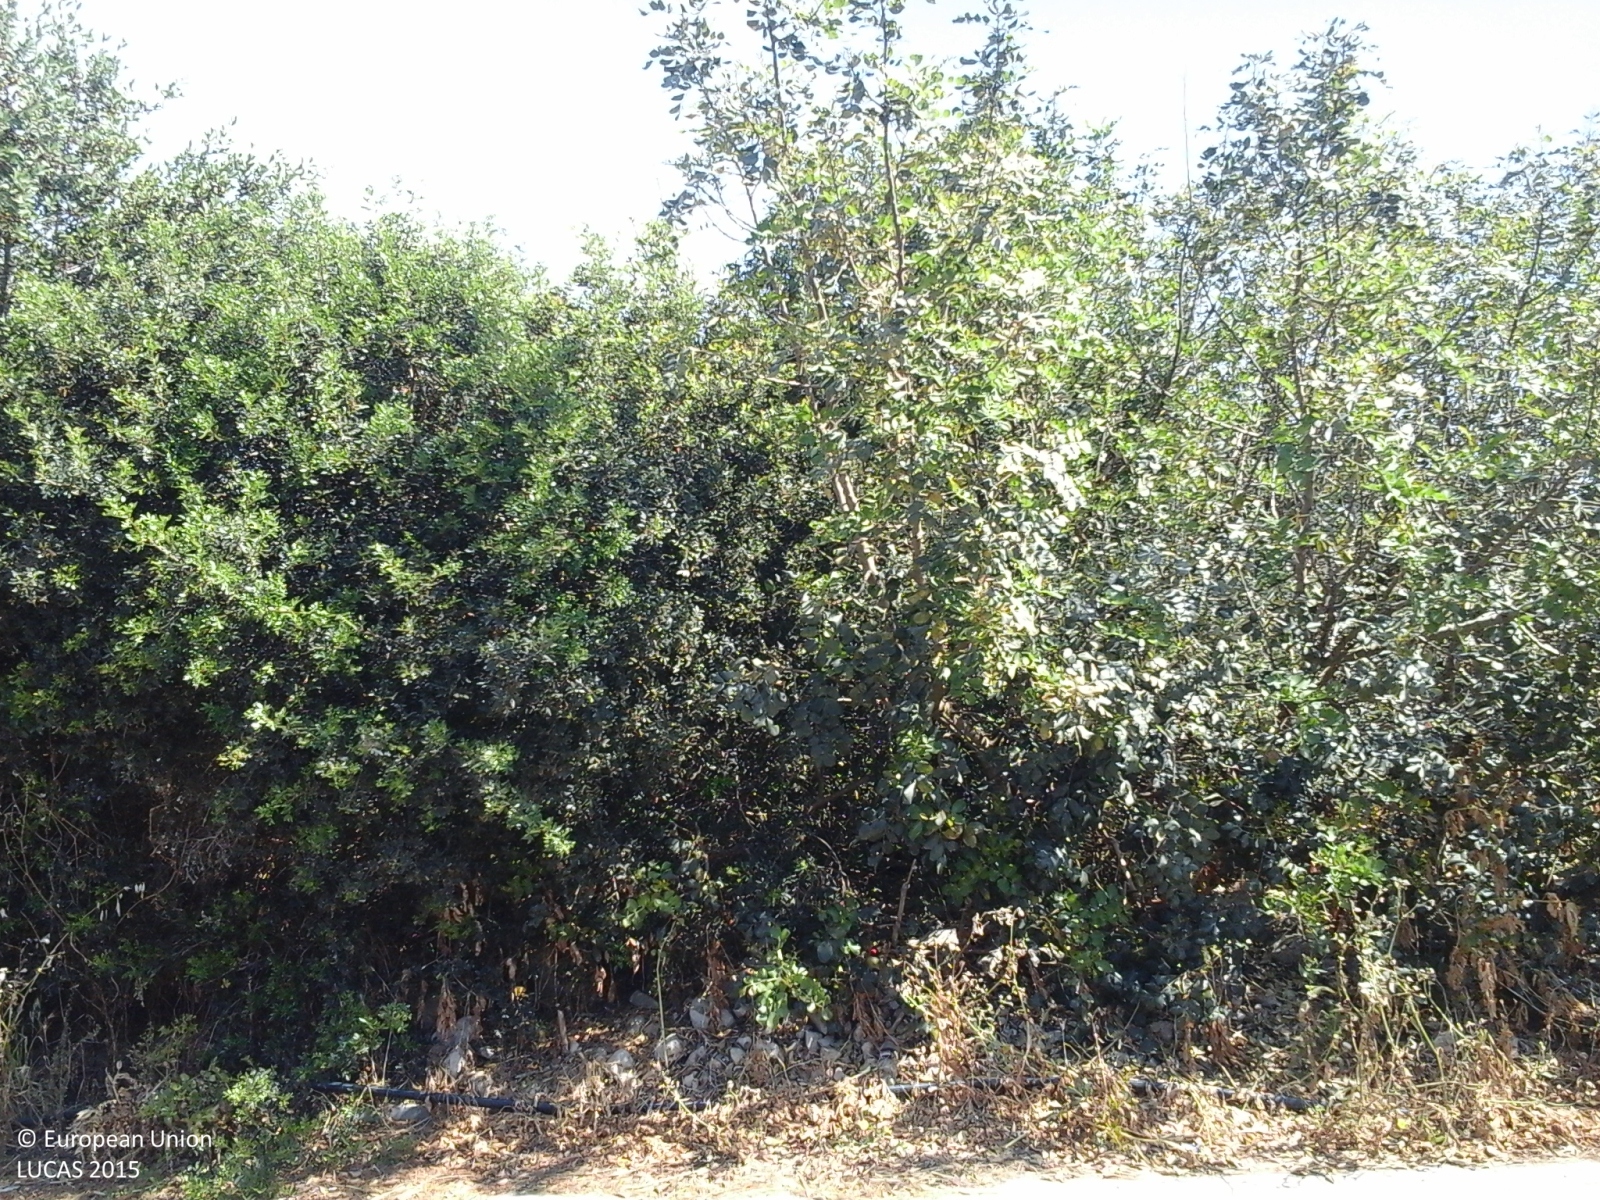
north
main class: Woodland
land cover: Pine dominated coniferous woodland
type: coniferous forest of the mediterranean region
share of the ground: > 75 %
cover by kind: coniferous forest trees 80 %, herbaceous plants 20 %
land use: Residential
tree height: > 5 m
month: May
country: MT
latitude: 35.8623
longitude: 14.3999
